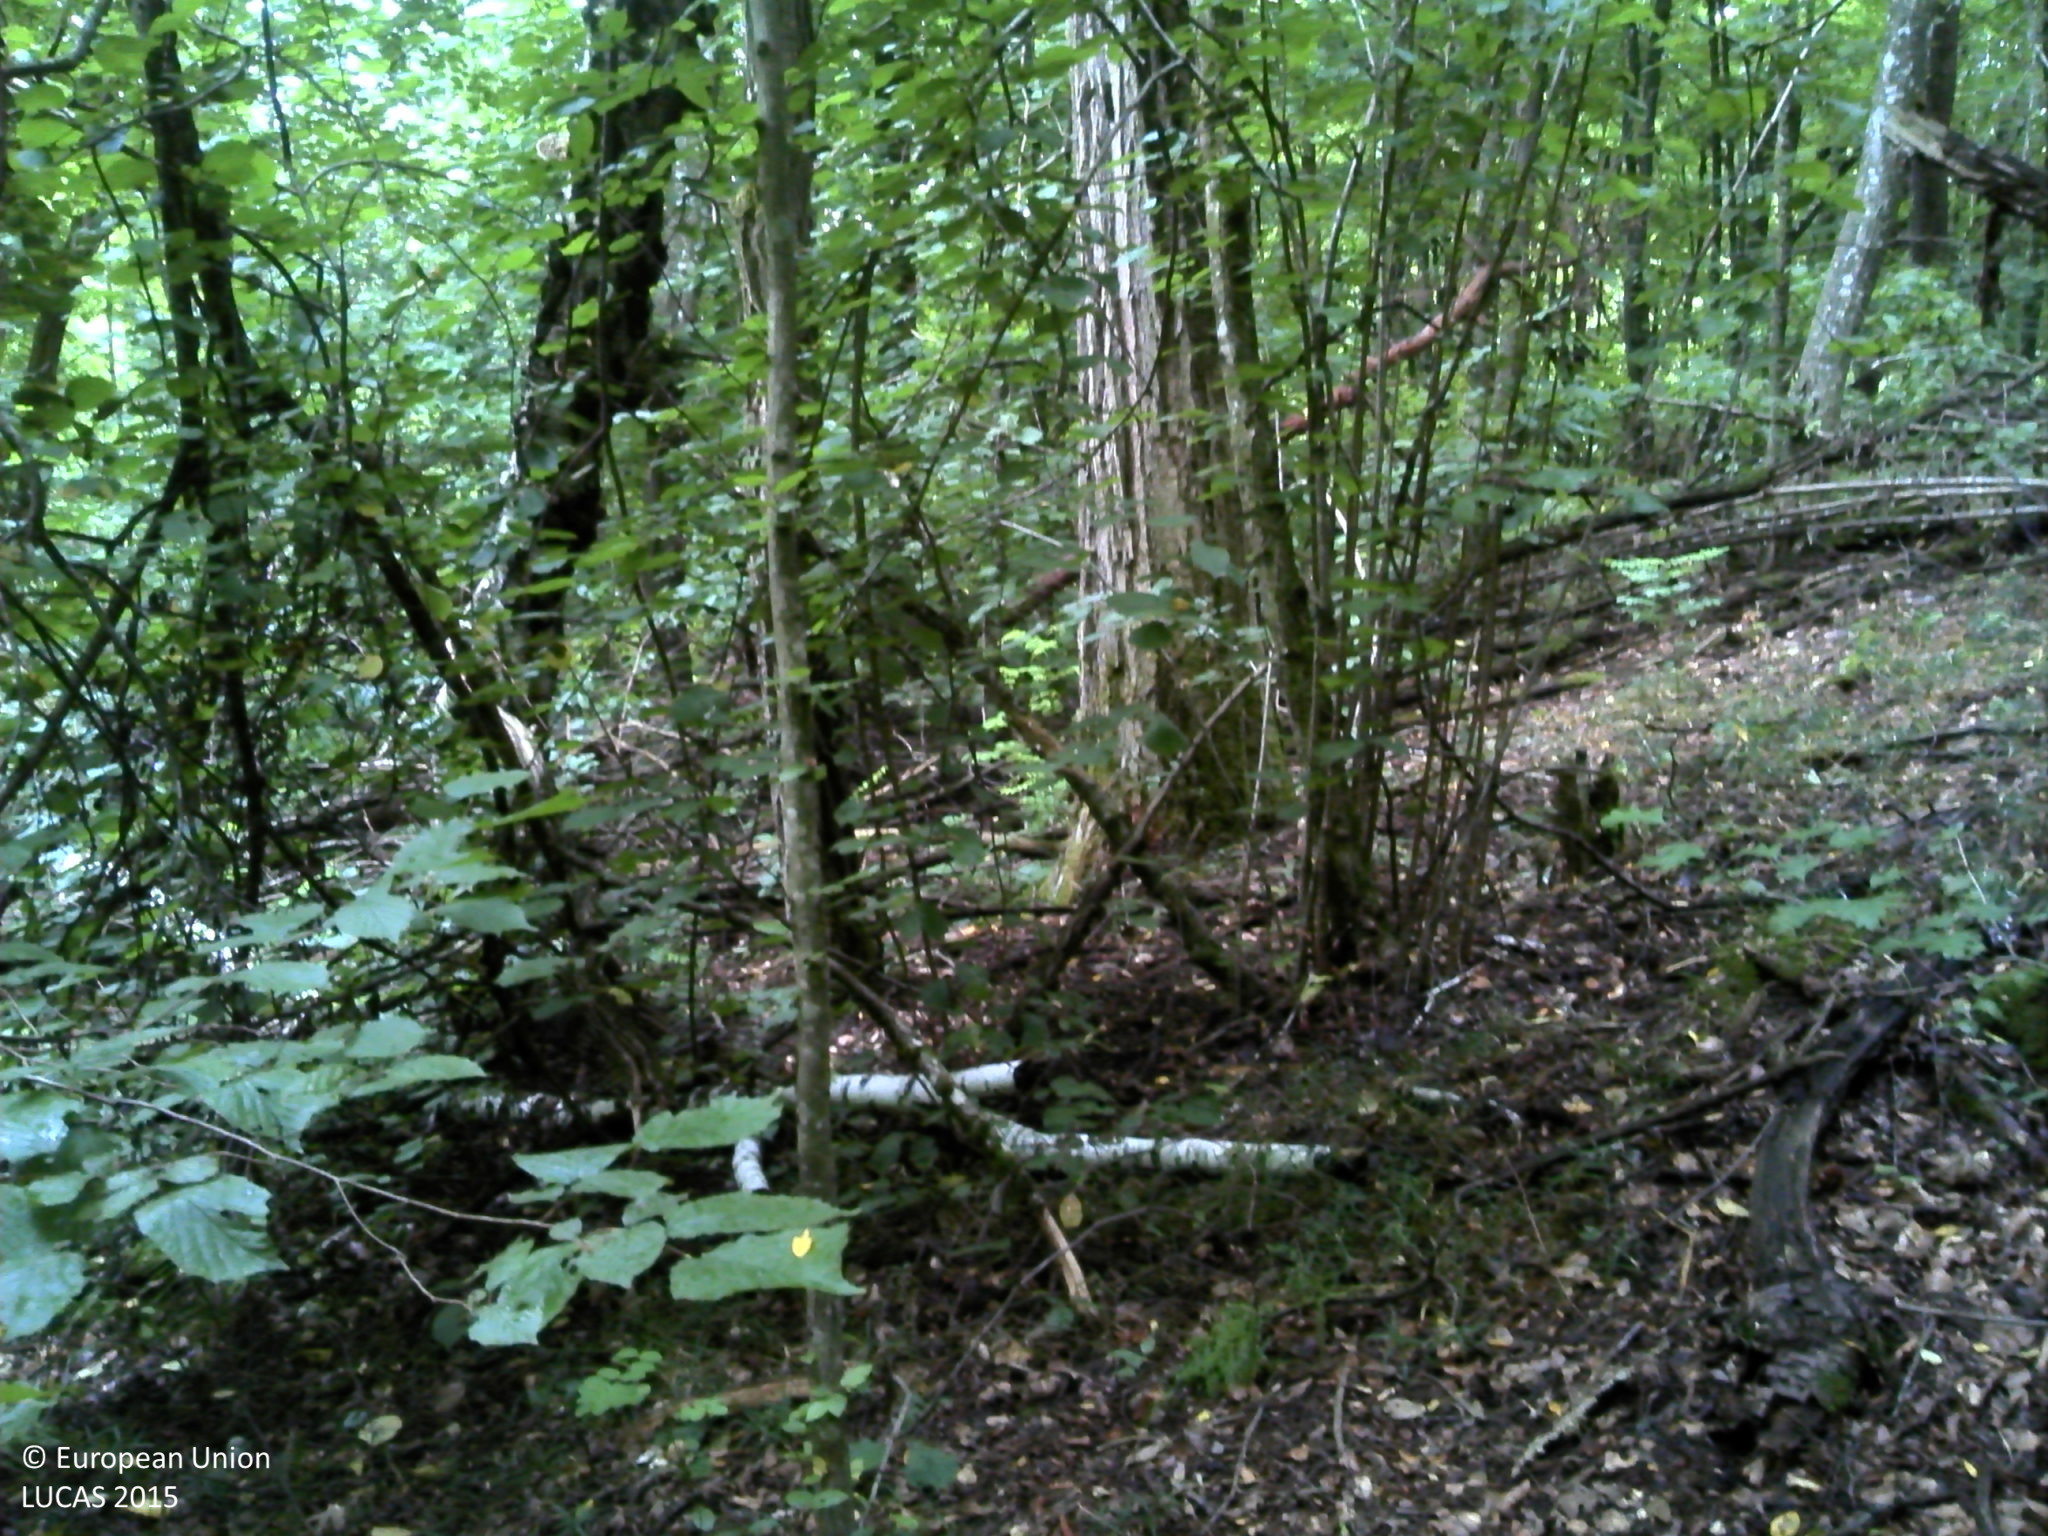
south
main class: Woodland
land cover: Broadleaved woodland
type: acidophilous oak and oak-birch forest
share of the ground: > 75 %
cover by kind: broadleaved forest trees 100 %
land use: Forestry
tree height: > 5 m
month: August
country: HR
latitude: 45.4263
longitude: 15.6326
